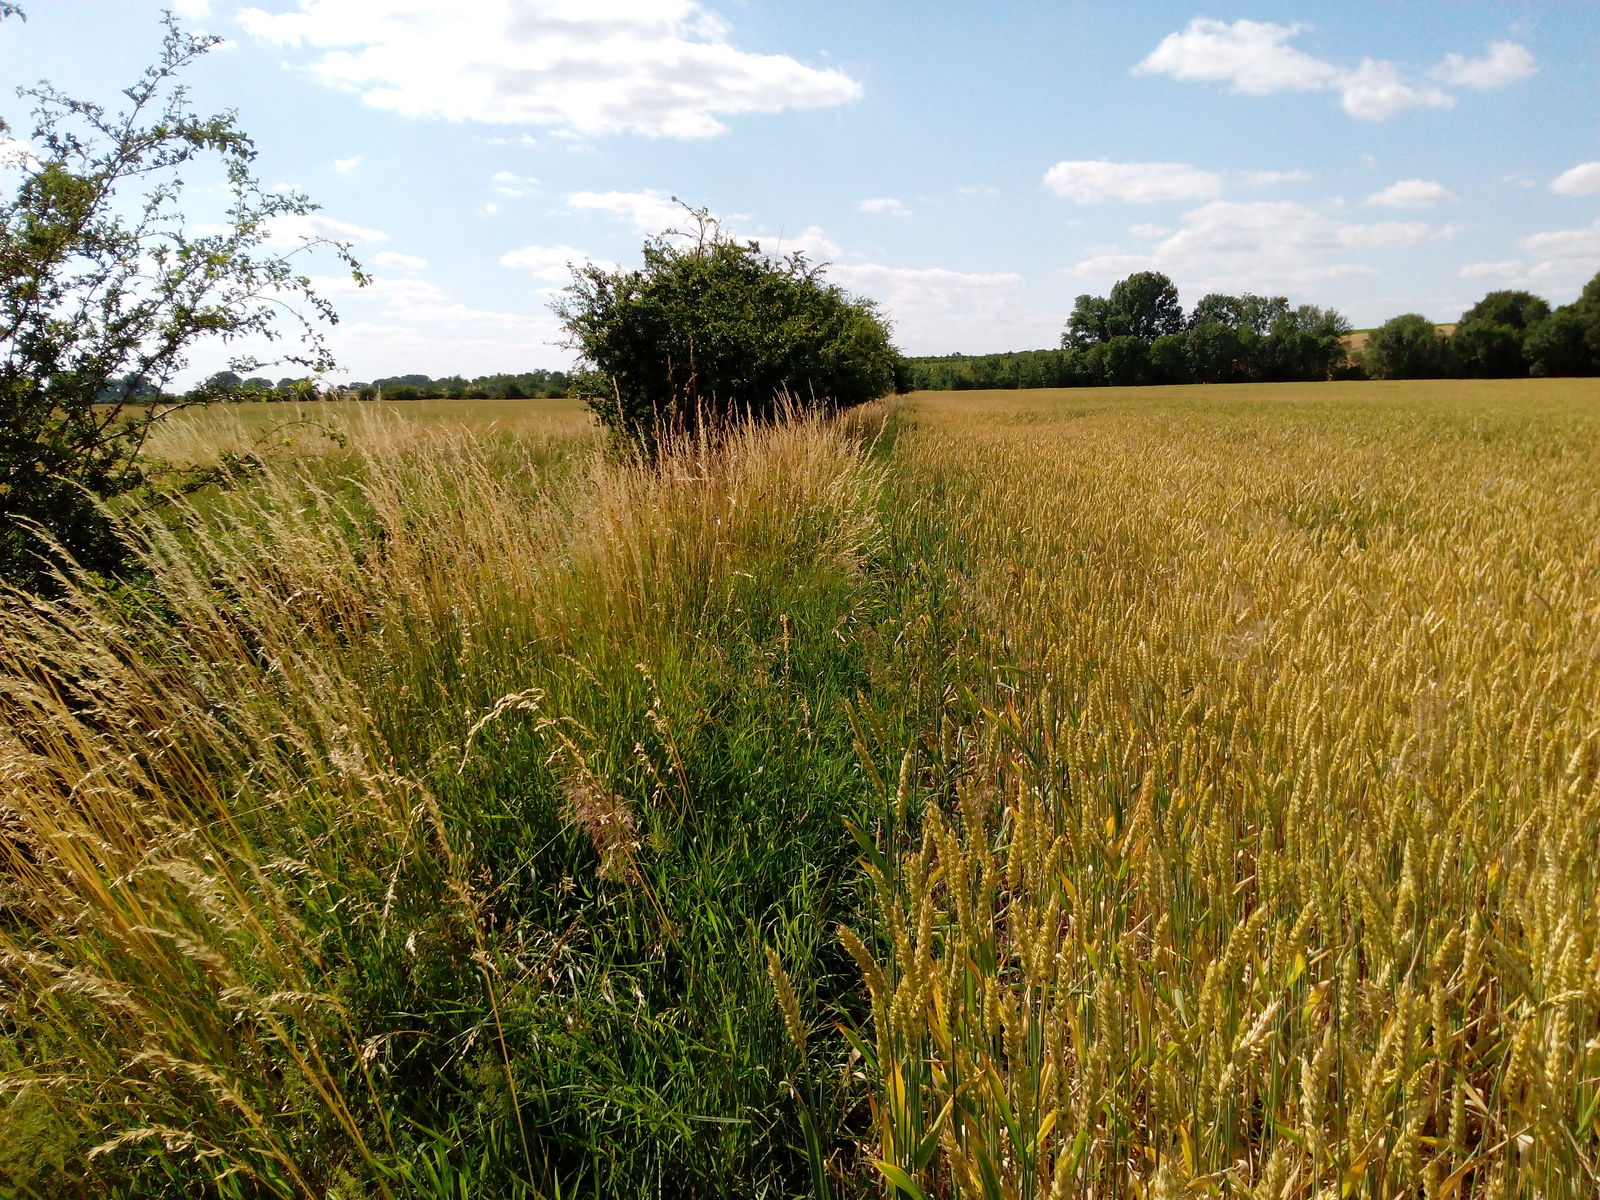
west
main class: Cropland
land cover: Common wheat
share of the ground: > 75 %
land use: Agriculture (excluding fallow land and kitchen gardens)
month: July
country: DE
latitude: 51.1140
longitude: 11.0996
